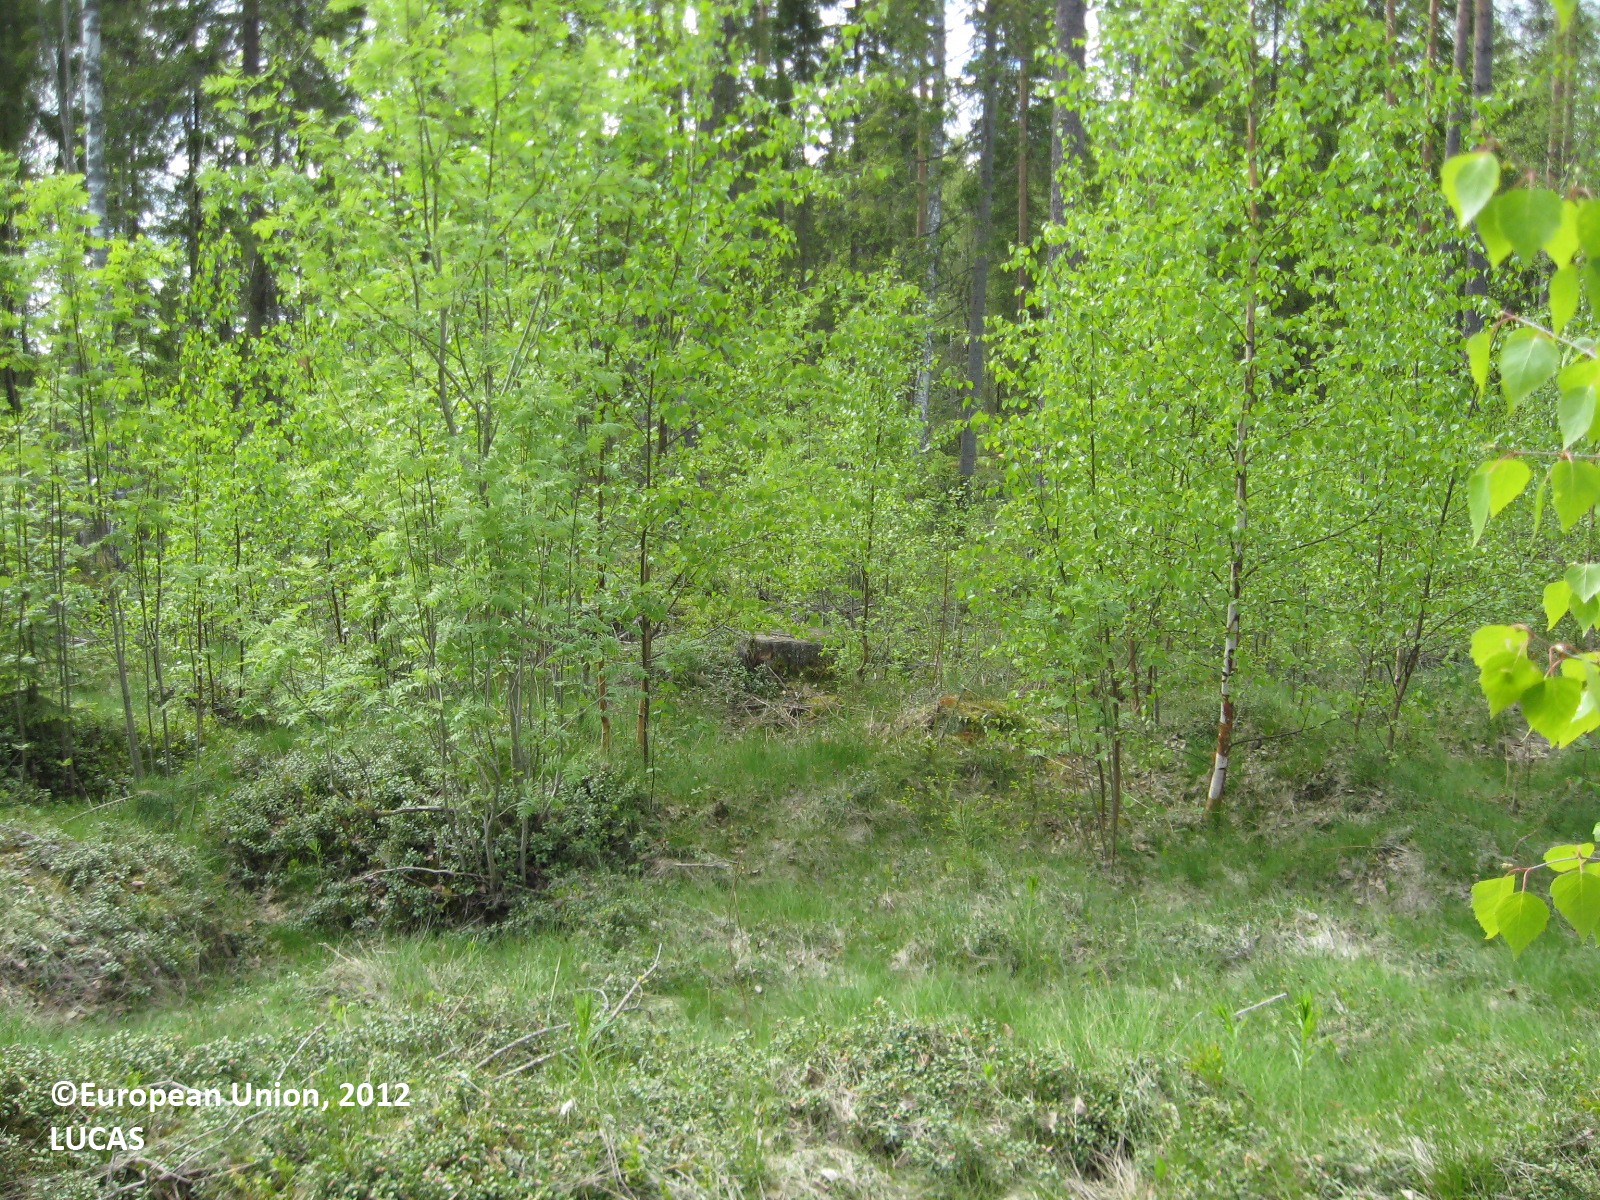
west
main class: Woodland
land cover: Other mixed woodland
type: boreal forest
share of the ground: 25 - 50 %
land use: Forestry
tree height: < 5 m
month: May
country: FI
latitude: 61.8411
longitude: 22.6183
